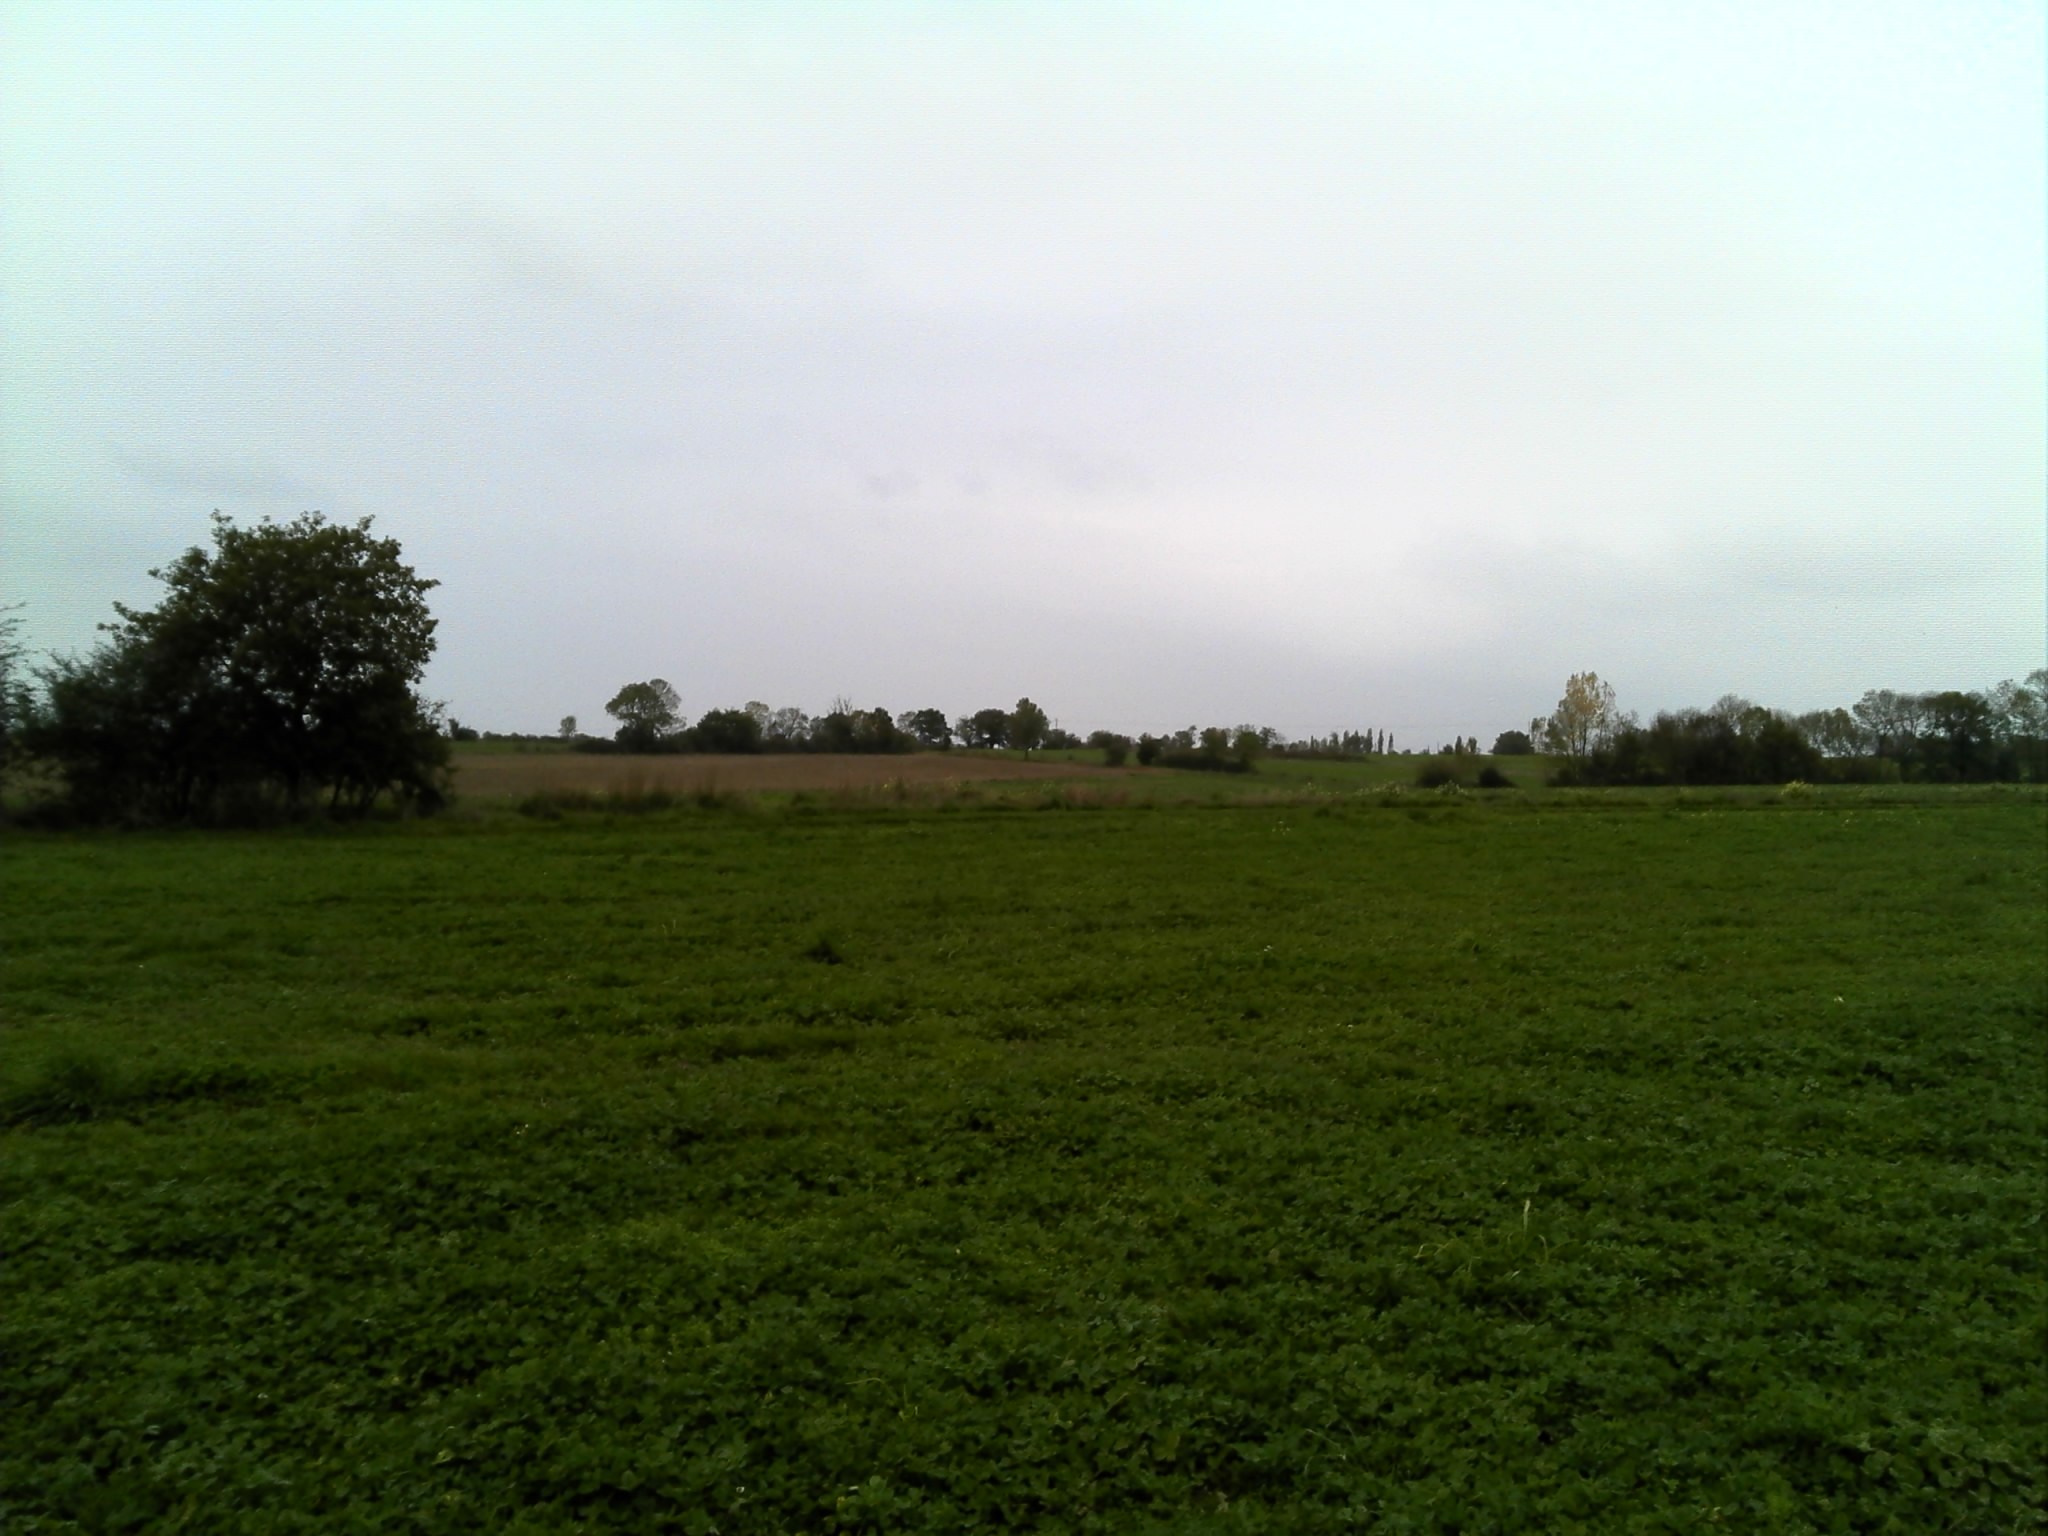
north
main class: Cropland
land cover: Clovers
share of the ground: > 75 %
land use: Agriculture (excluding fallow land and kitchen gardens)
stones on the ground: 10 - 25 %
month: October
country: FR
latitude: 47.2632
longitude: -1.2591
